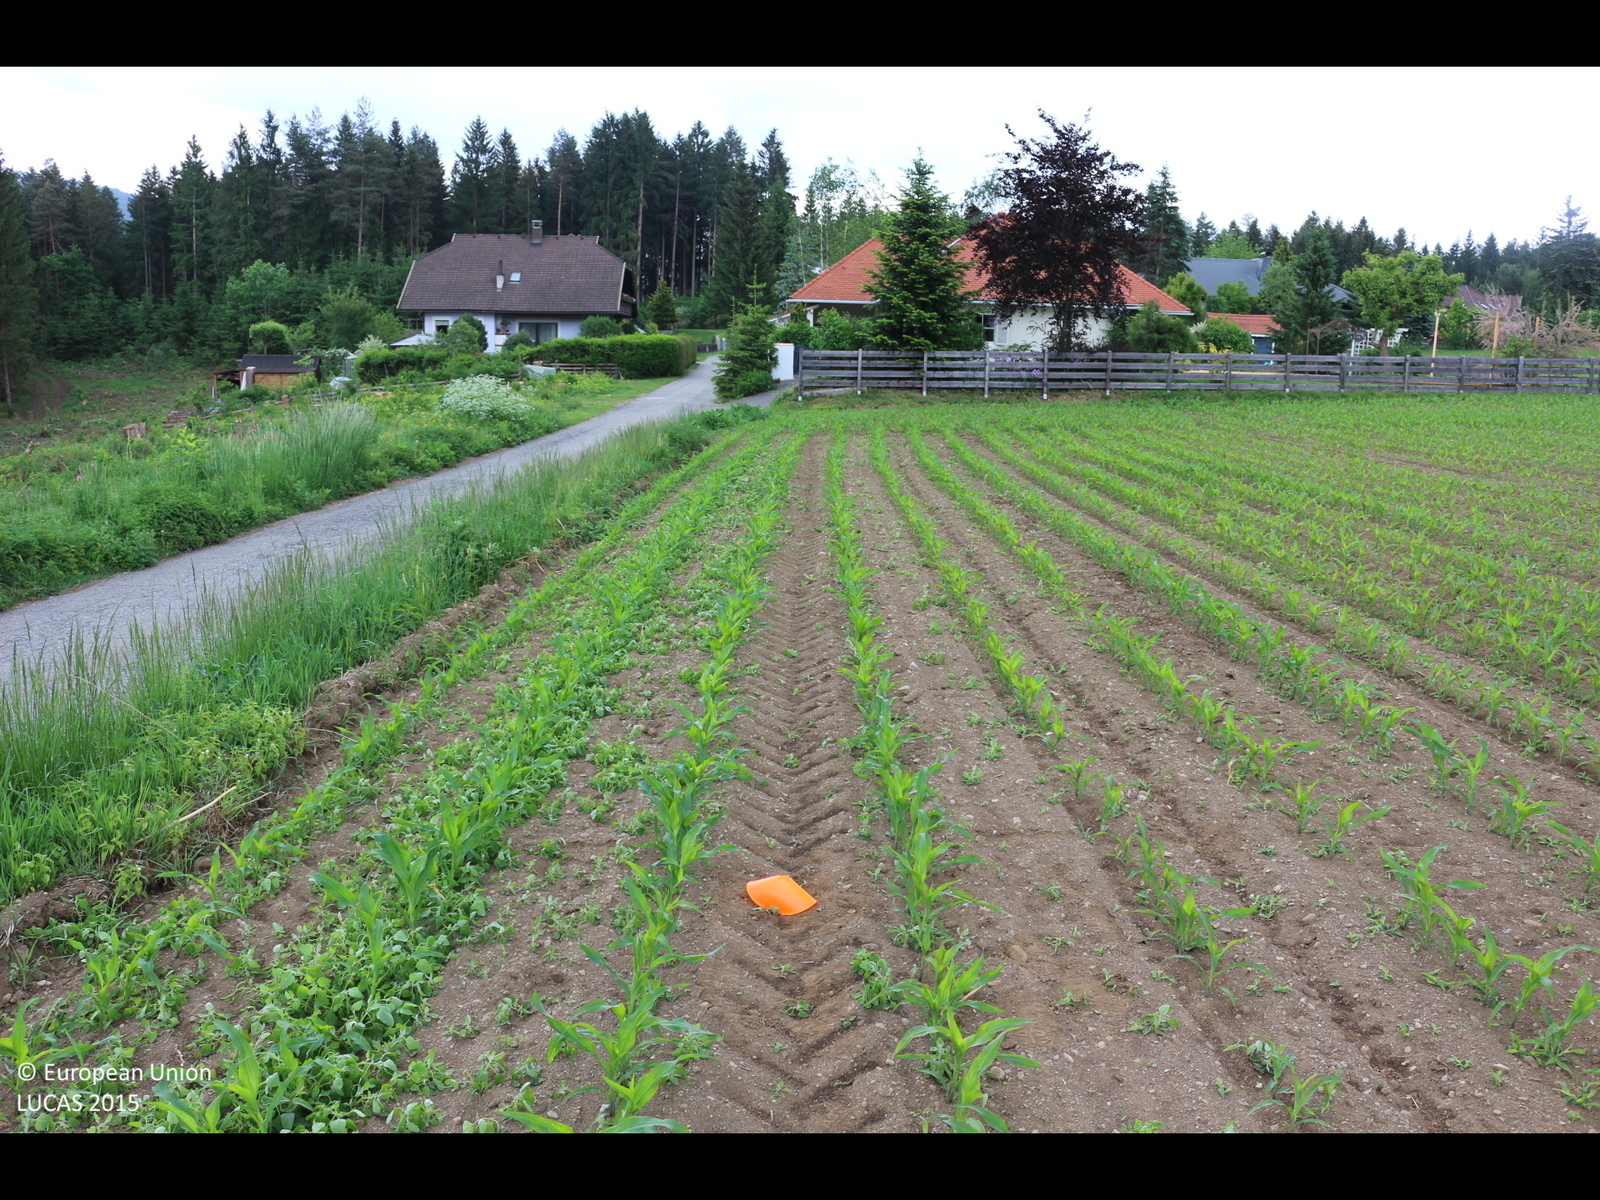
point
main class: Cropland
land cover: Maize
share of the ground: < 10 %
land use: Agriculture (excluding fallow land and kitchen gardens)
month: May
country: AT
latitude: 46.7187
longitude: 14.2233
